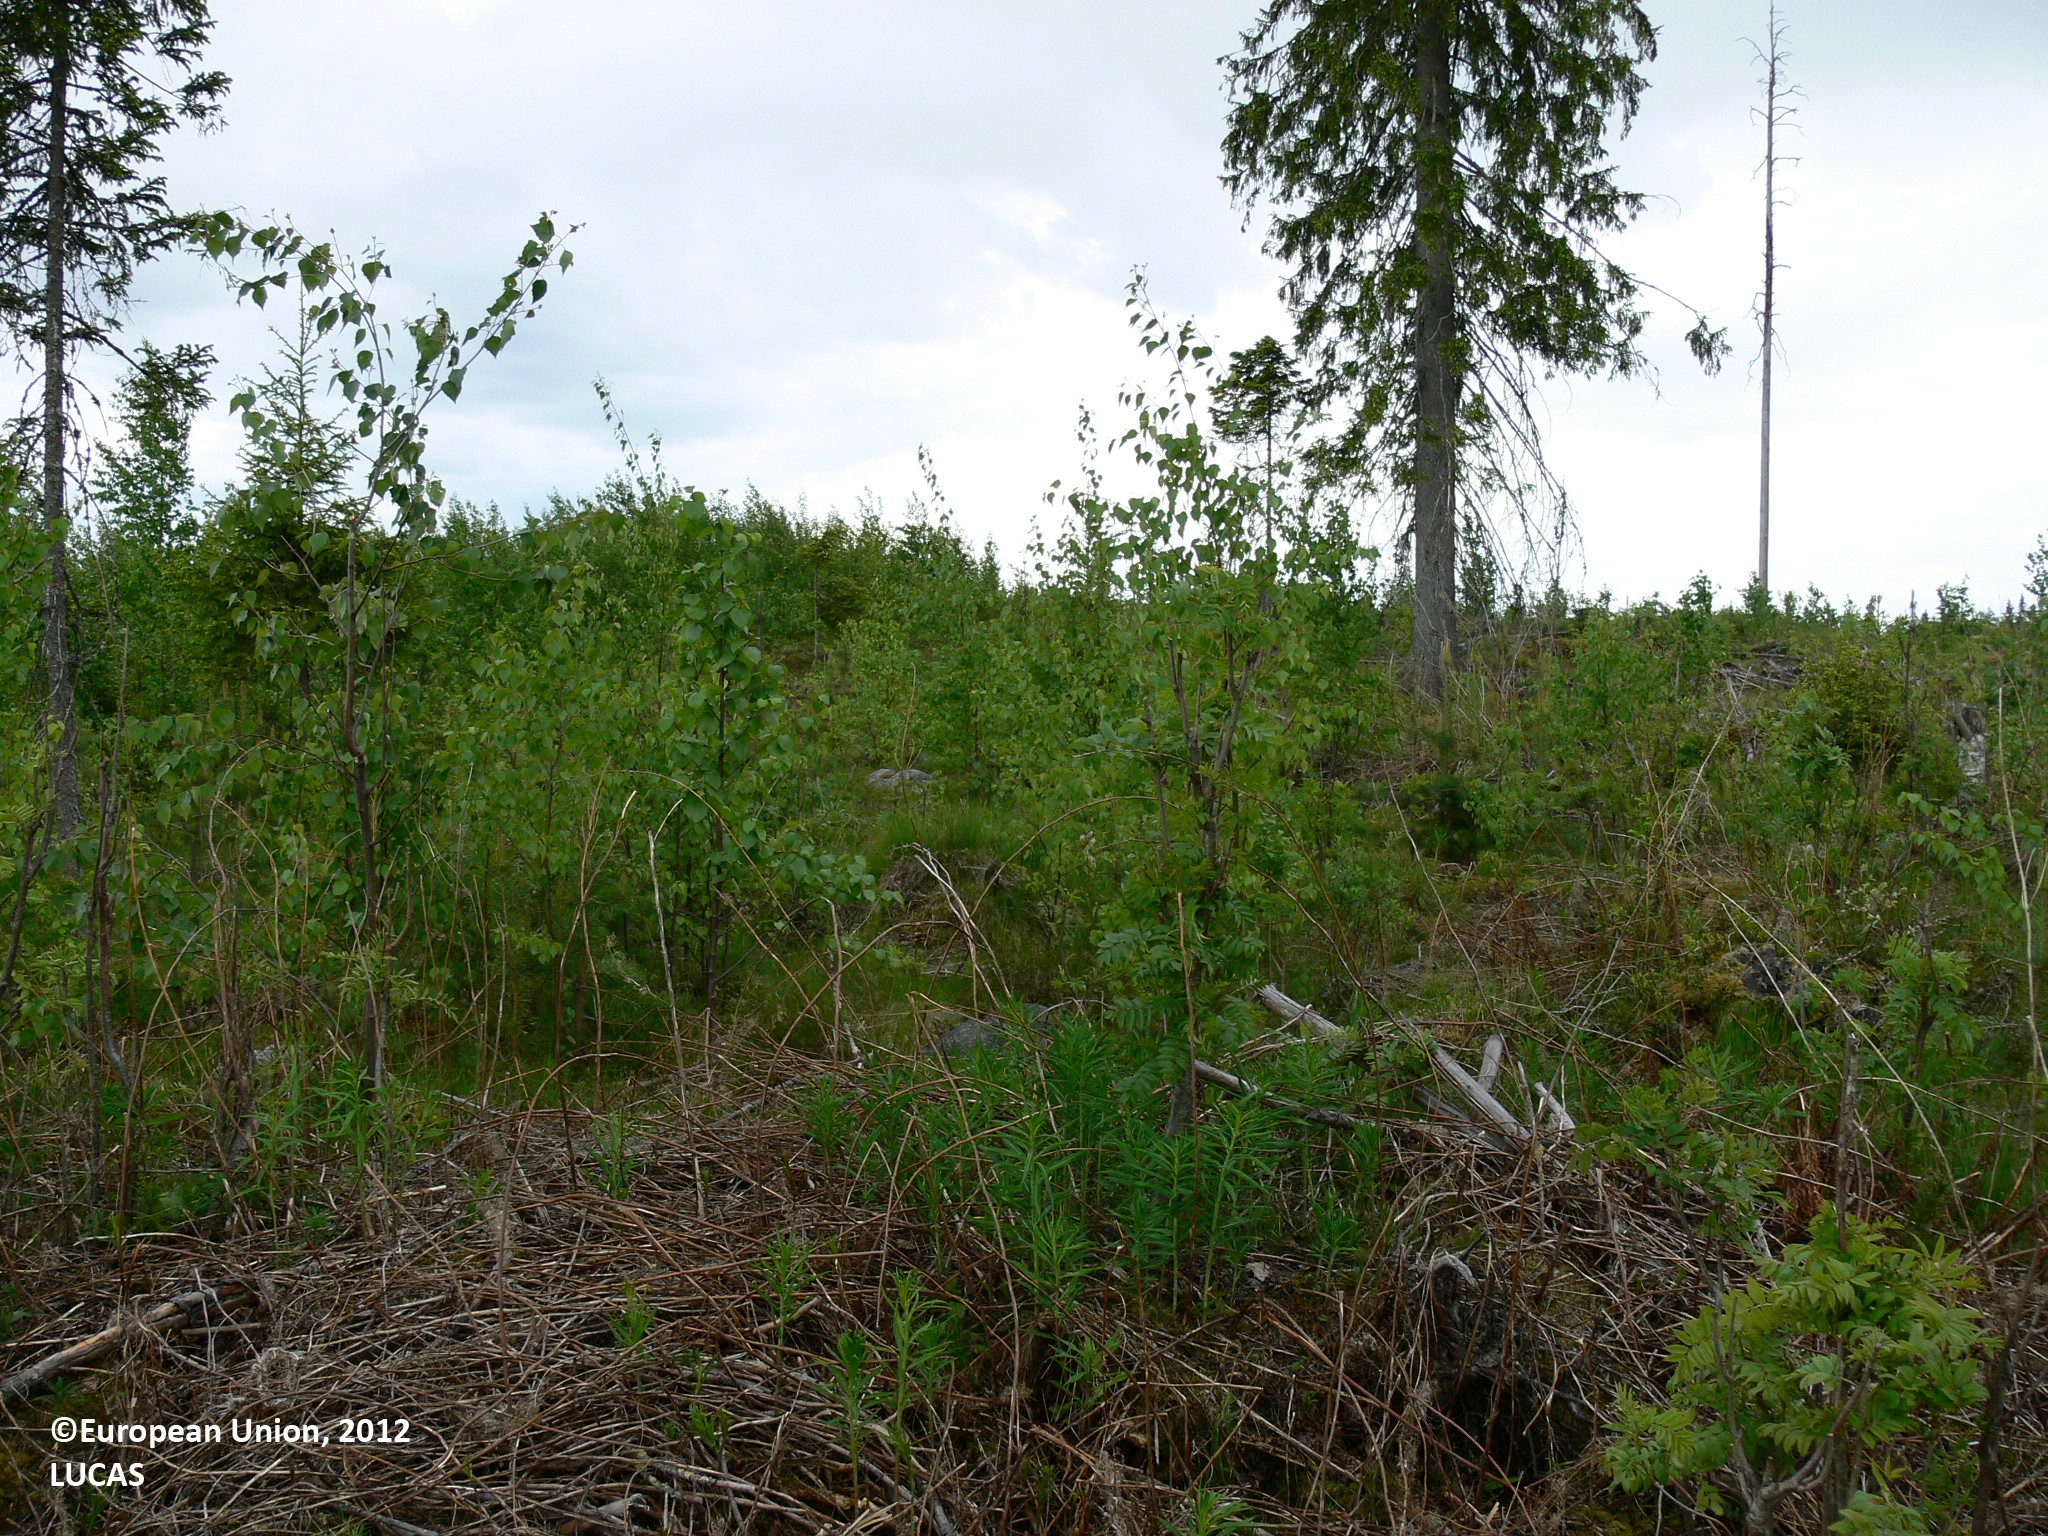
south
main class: Woodland
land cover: Other mixed woodland
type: boreal forest
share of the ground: 25 - 50 %
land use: Forestry
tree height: < 5 m
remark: Clear cut
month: June
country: FI
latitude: 62.6415
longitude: 30.3444
